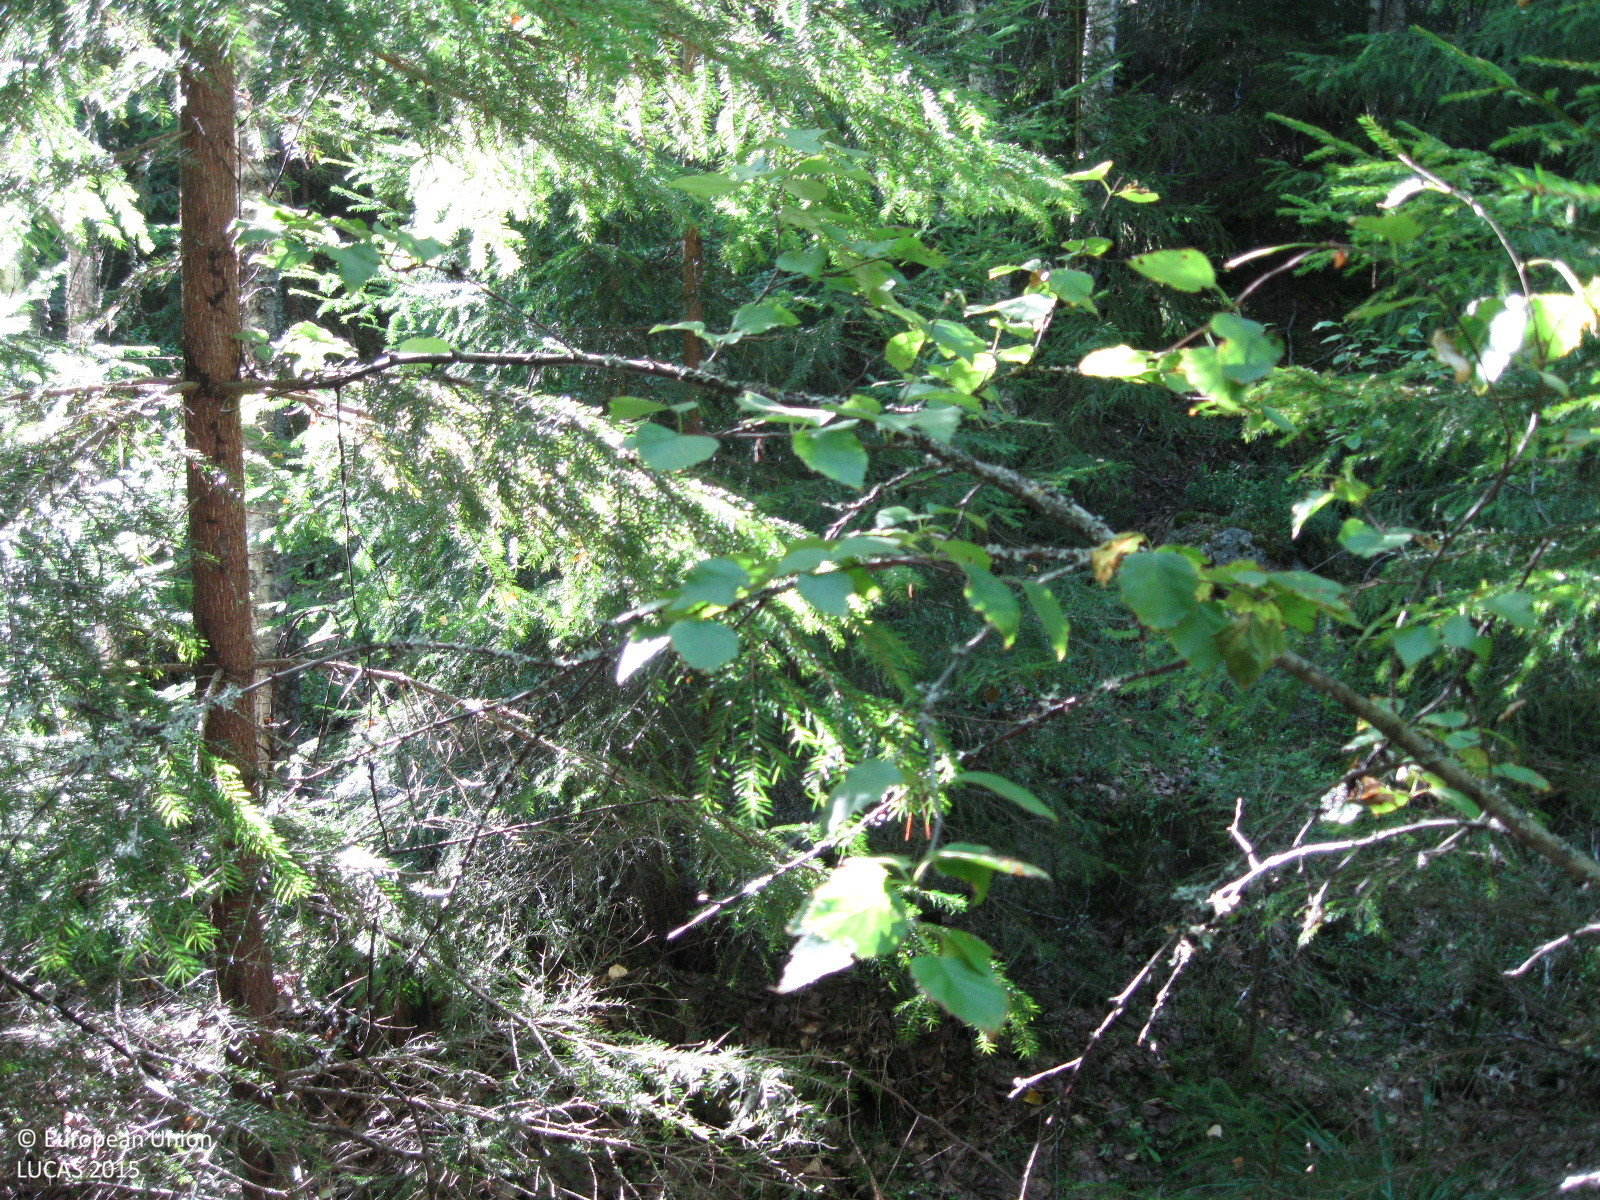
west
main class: Woodland
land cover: Spruce dominated mixed woodland
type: boreal forest
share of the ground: > 75 %
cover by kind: broadleaved forest trees 60 %, coniferous forest trees 30 %, herbaceous plants 10 %
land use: Forestry
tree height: > 5 m
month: August
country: FI
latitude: 61.2219
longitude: 25.0657
